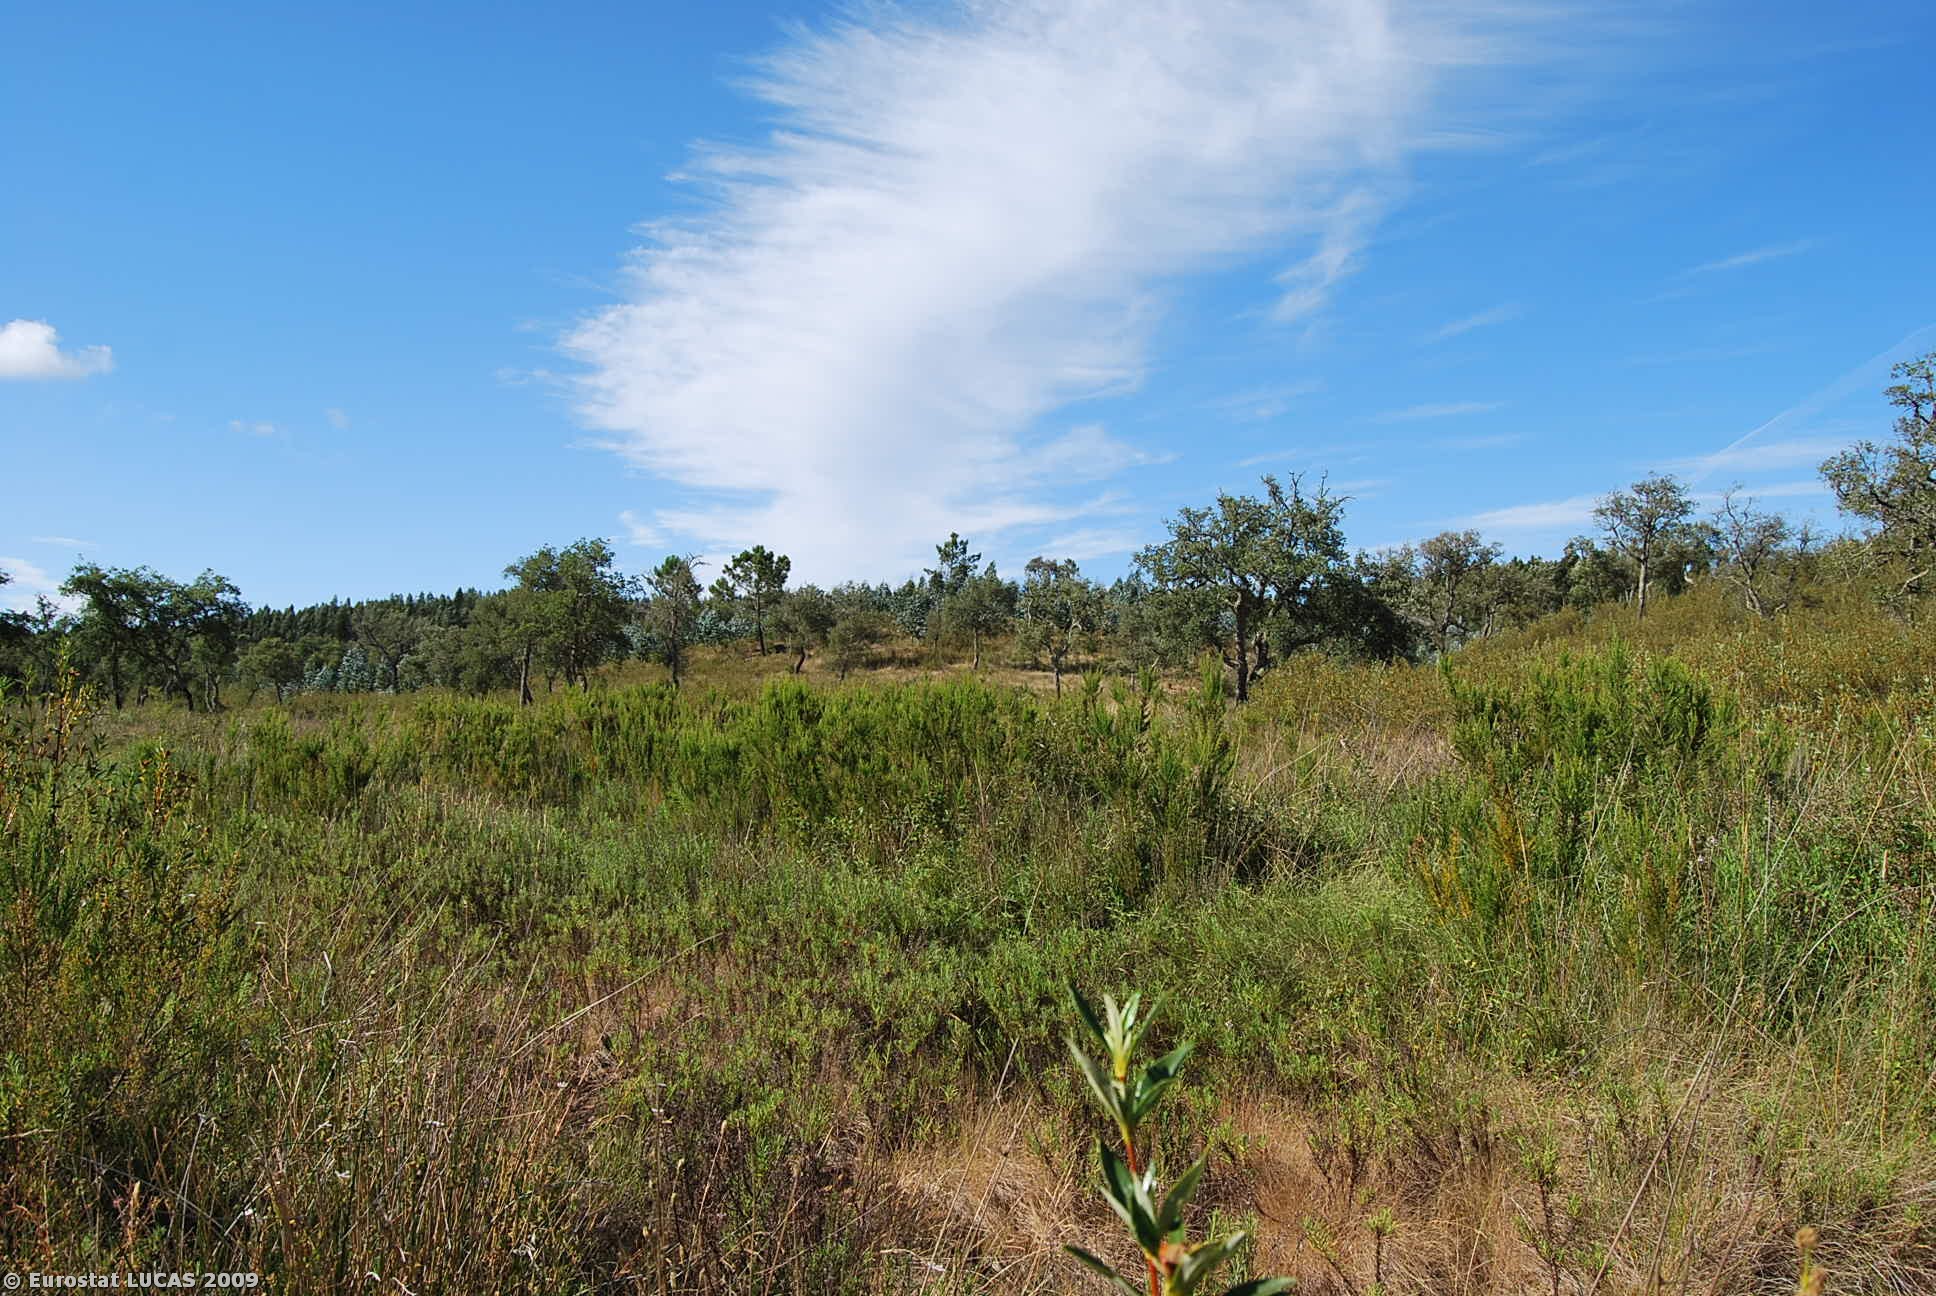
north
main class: Shrubland
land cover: Shrubland with sparse tree cover
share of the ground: > 75 %
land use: Unused
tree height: > 5 m
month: June
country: PT
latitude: 37.9511
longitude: -8.6996
